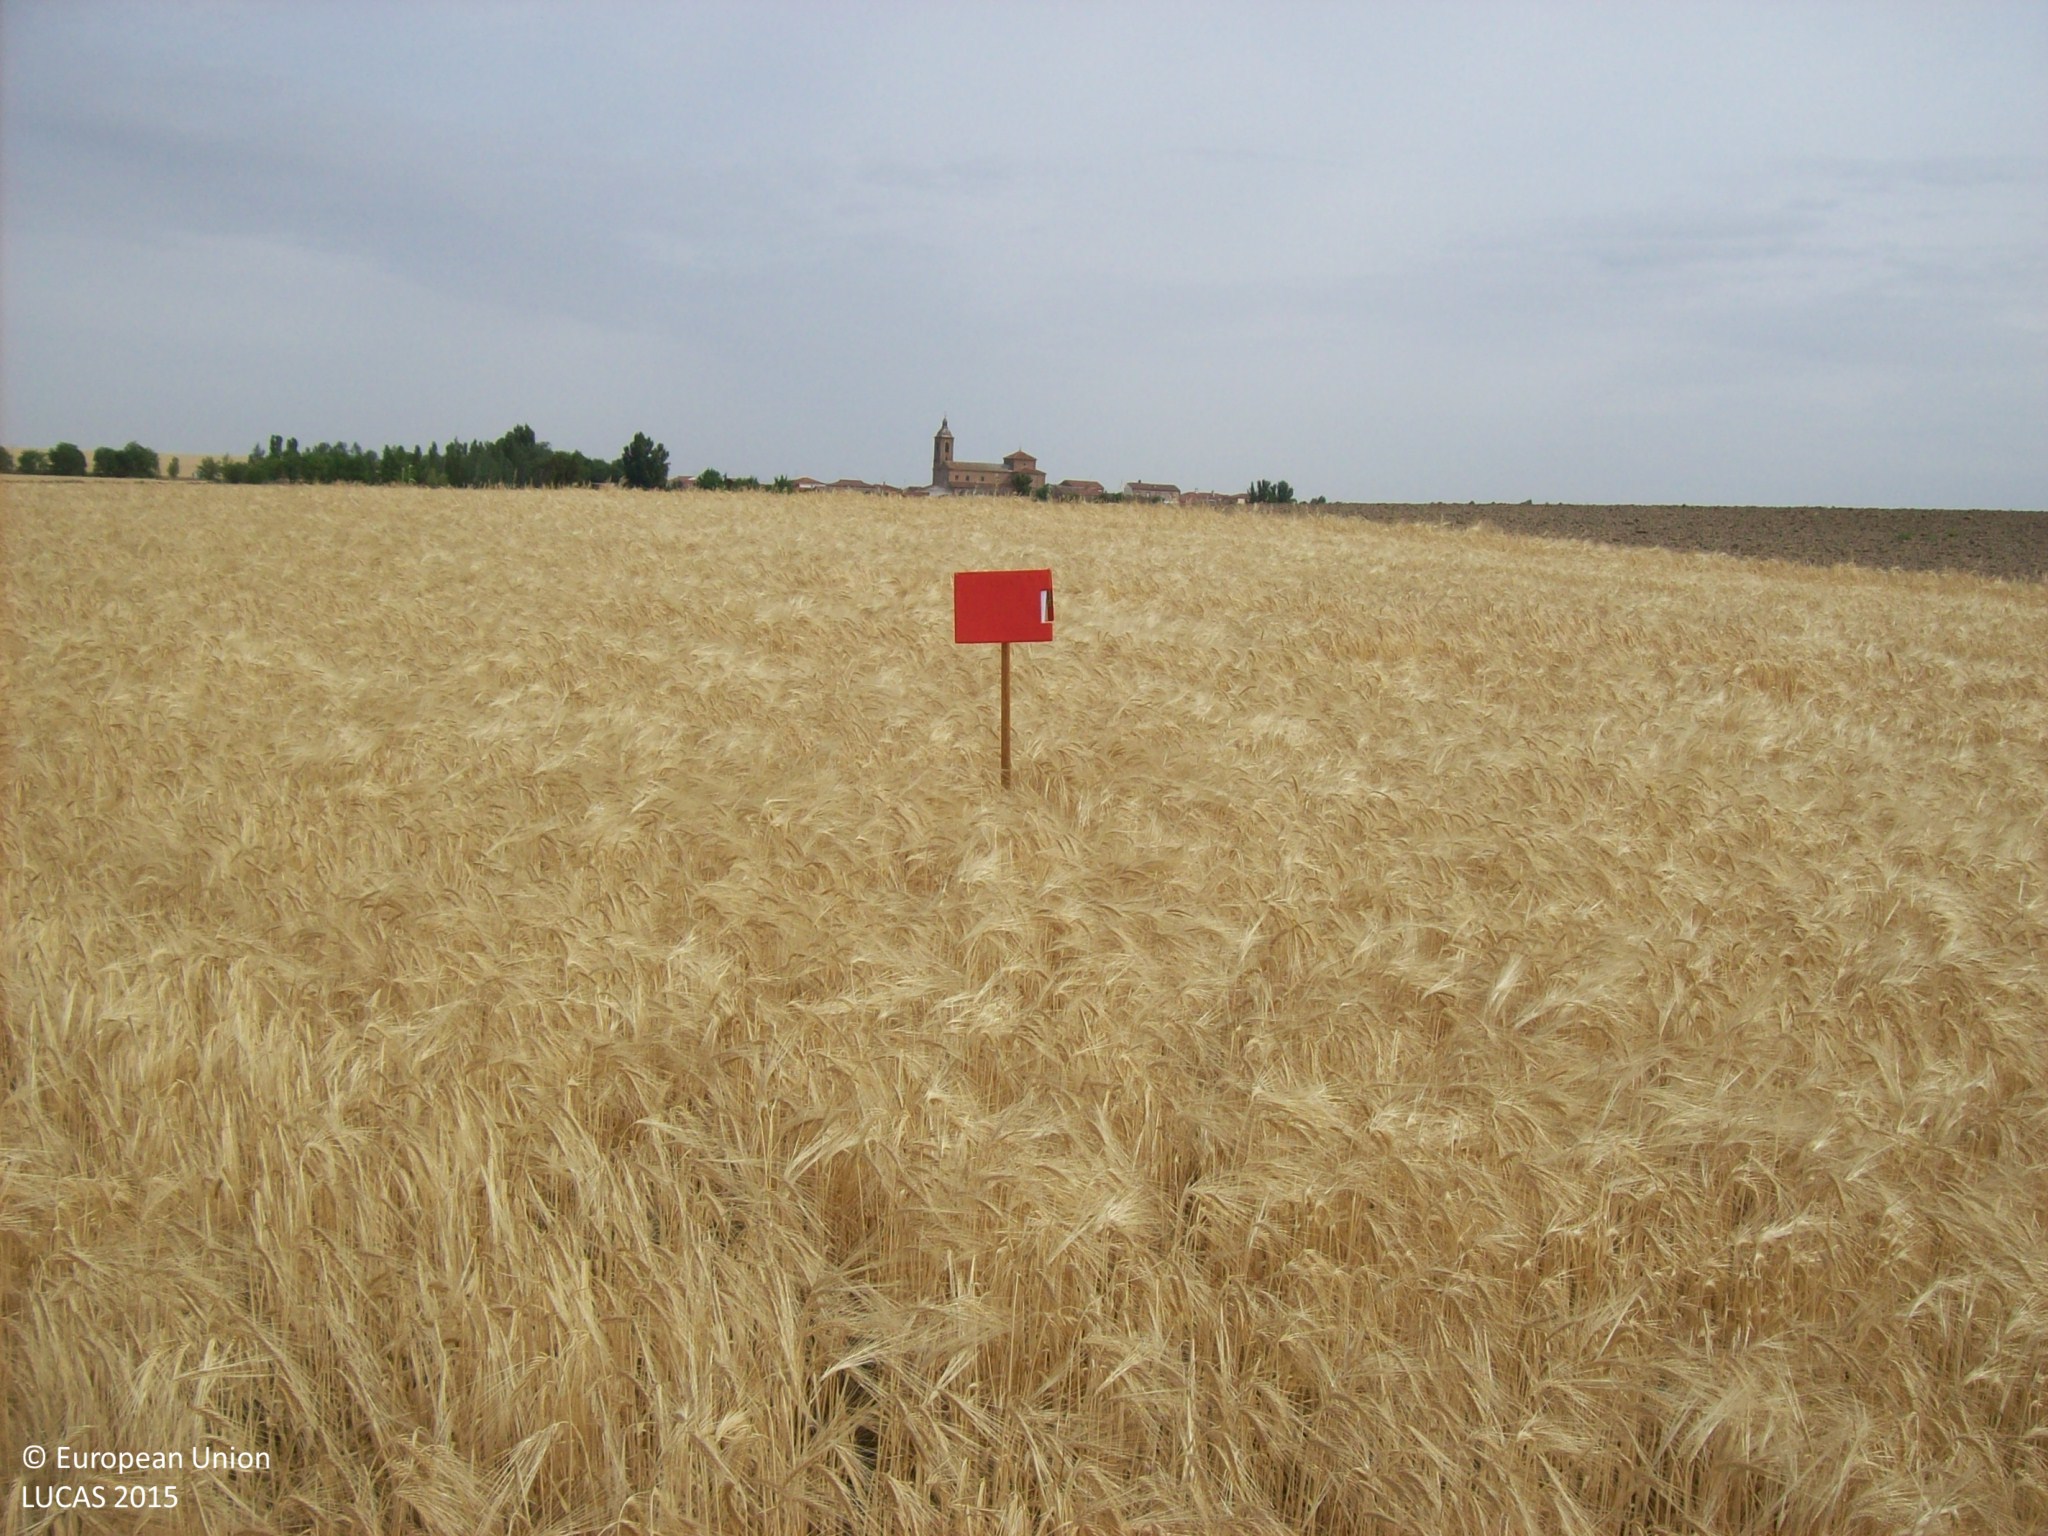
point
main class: Cropland
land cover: Barley
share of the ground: > 75 %
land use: Agriculture (excluding fallow land and kitchen gardens)
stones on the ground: < 10 %
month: June
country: ES
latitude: 41.0389
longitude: -4.9704
